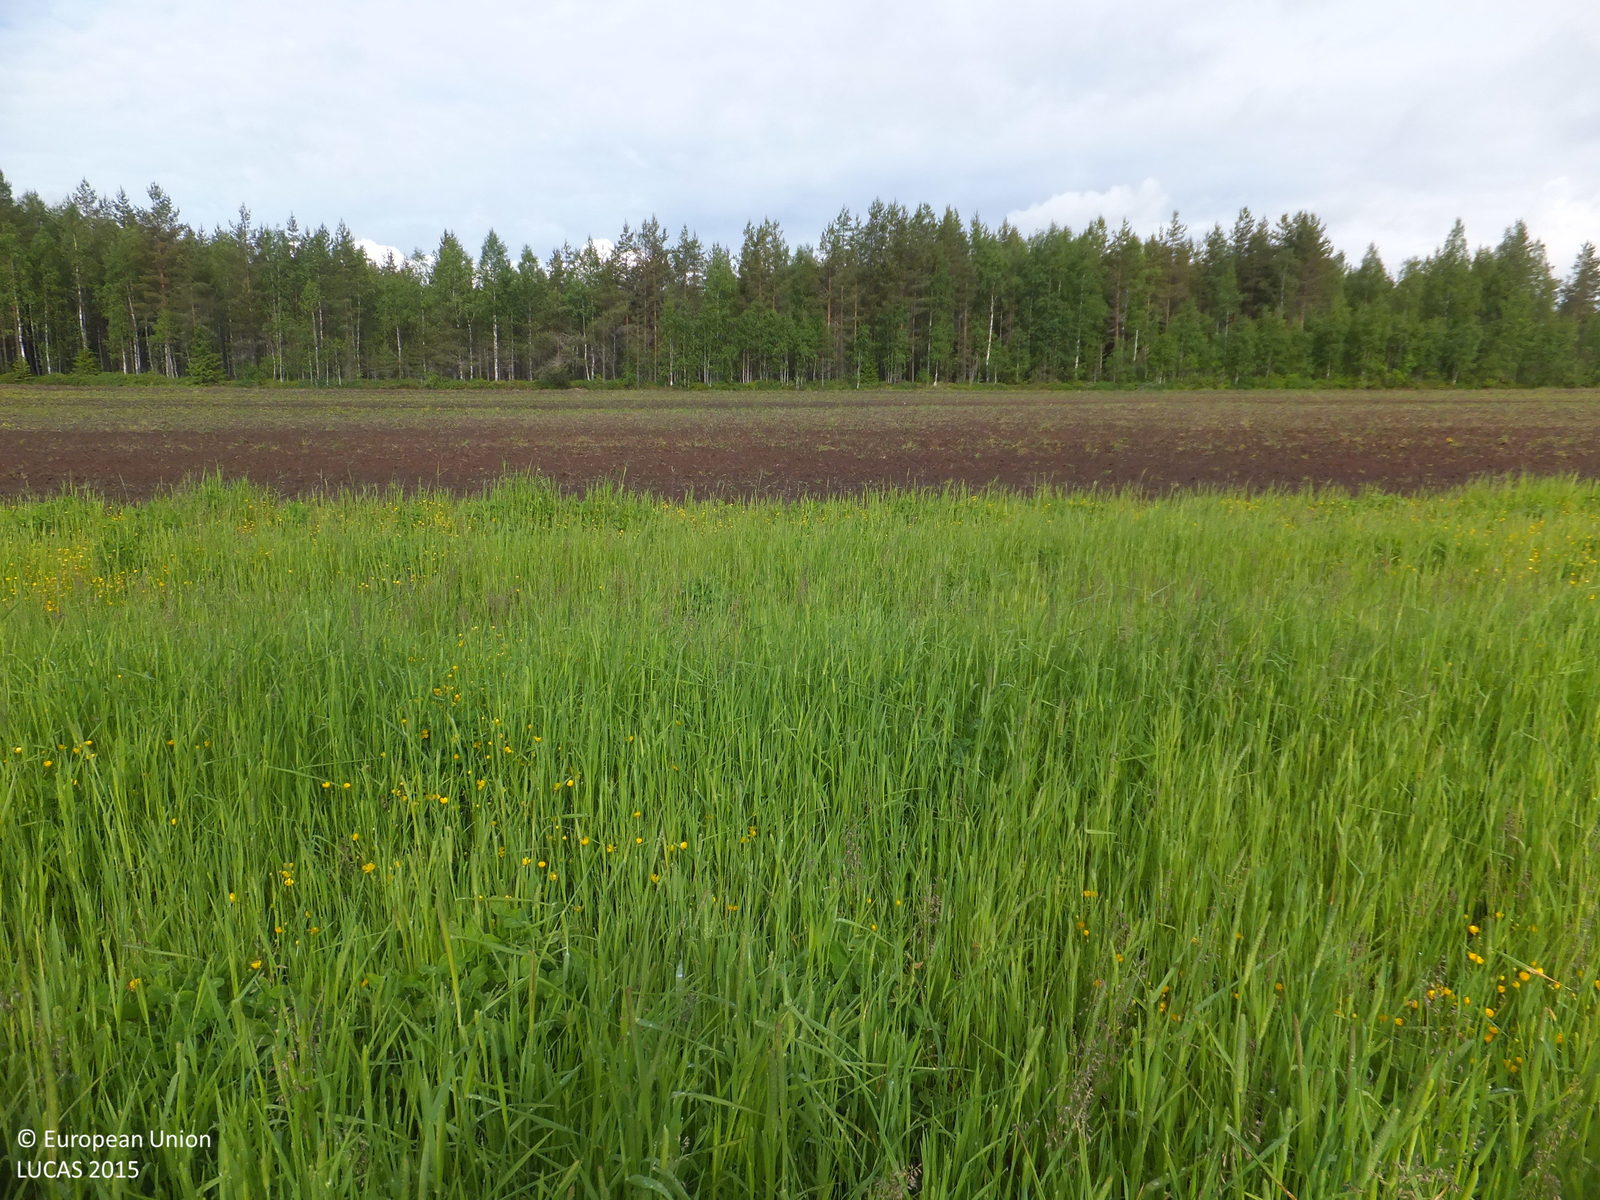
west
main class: Cropland
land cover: Temporary grasslands
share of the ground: > 75 %
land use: Agriculture (excluding fallow land and kitchen gardens)
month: June
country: FI
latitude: 63.3680
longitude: 24.0090
